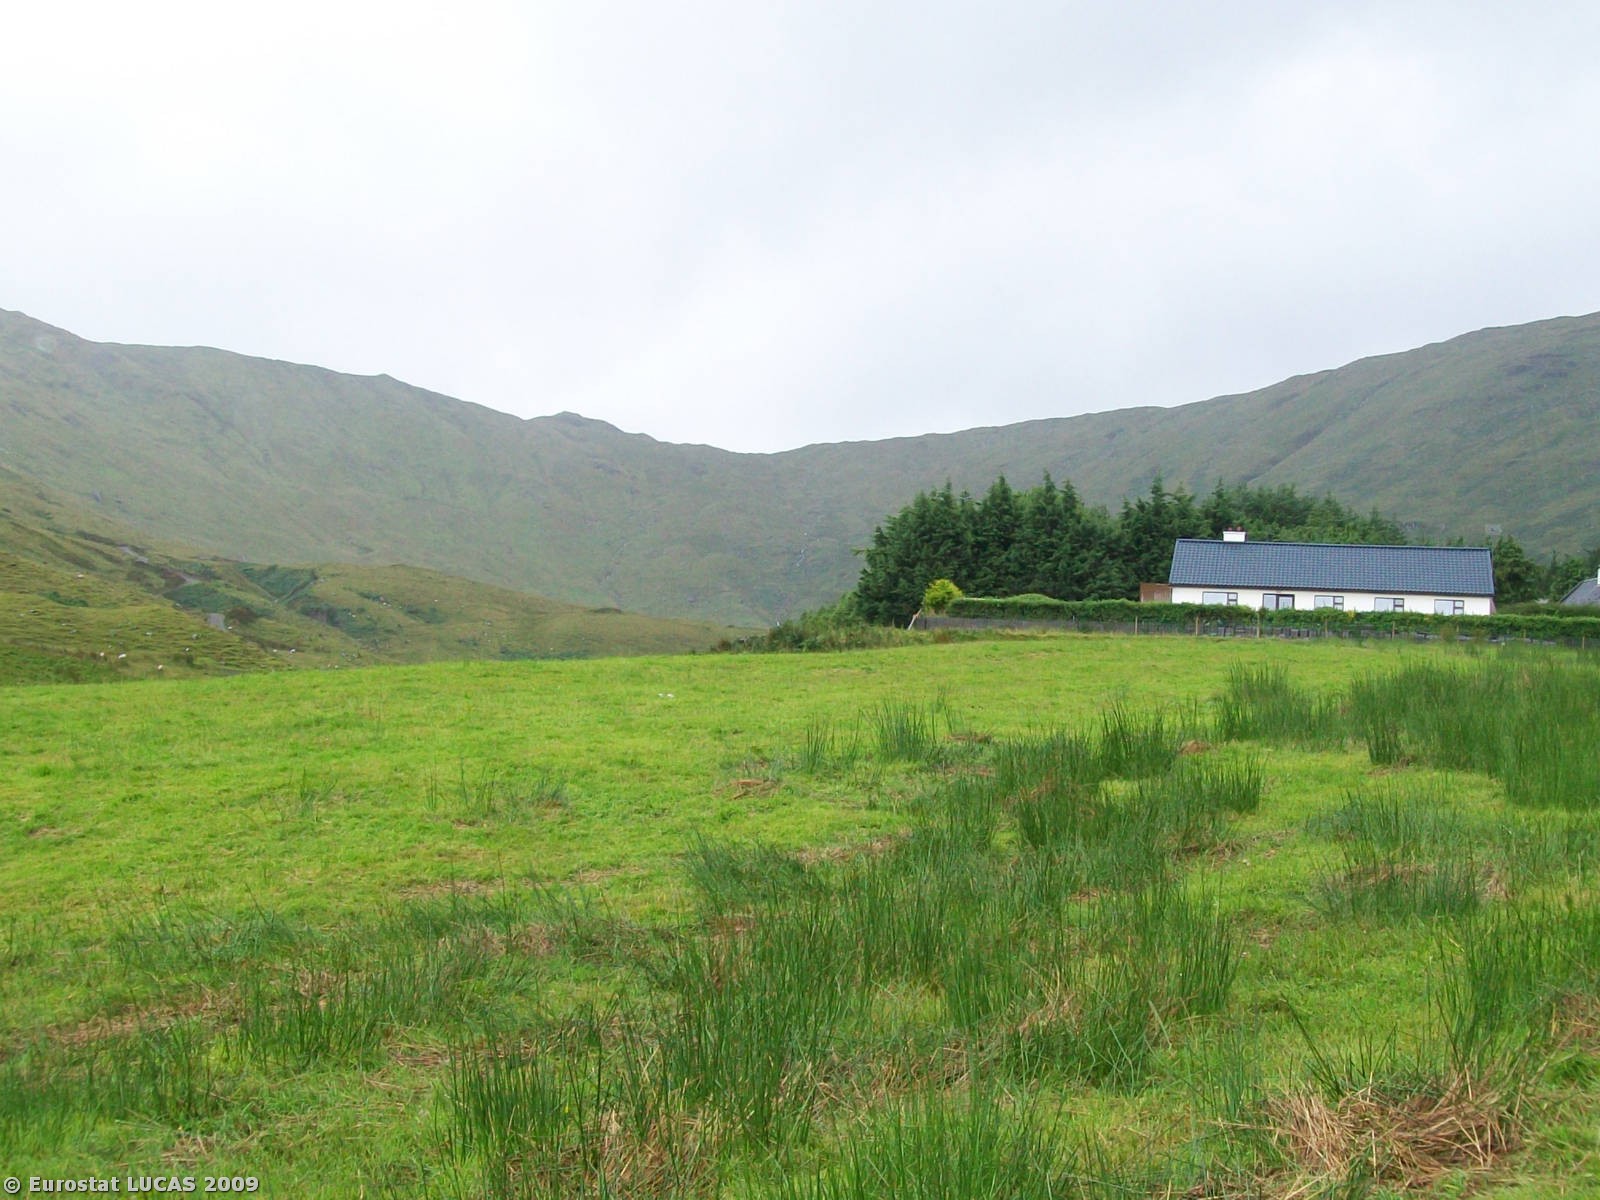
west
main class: Grassland
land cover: Grassland without tree/shrub cover
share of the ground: > 75 %
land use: Agriculture (excluding fallow land and kitchen gardens)
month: July
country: IE
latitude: 53.5309
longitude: -9.5293
